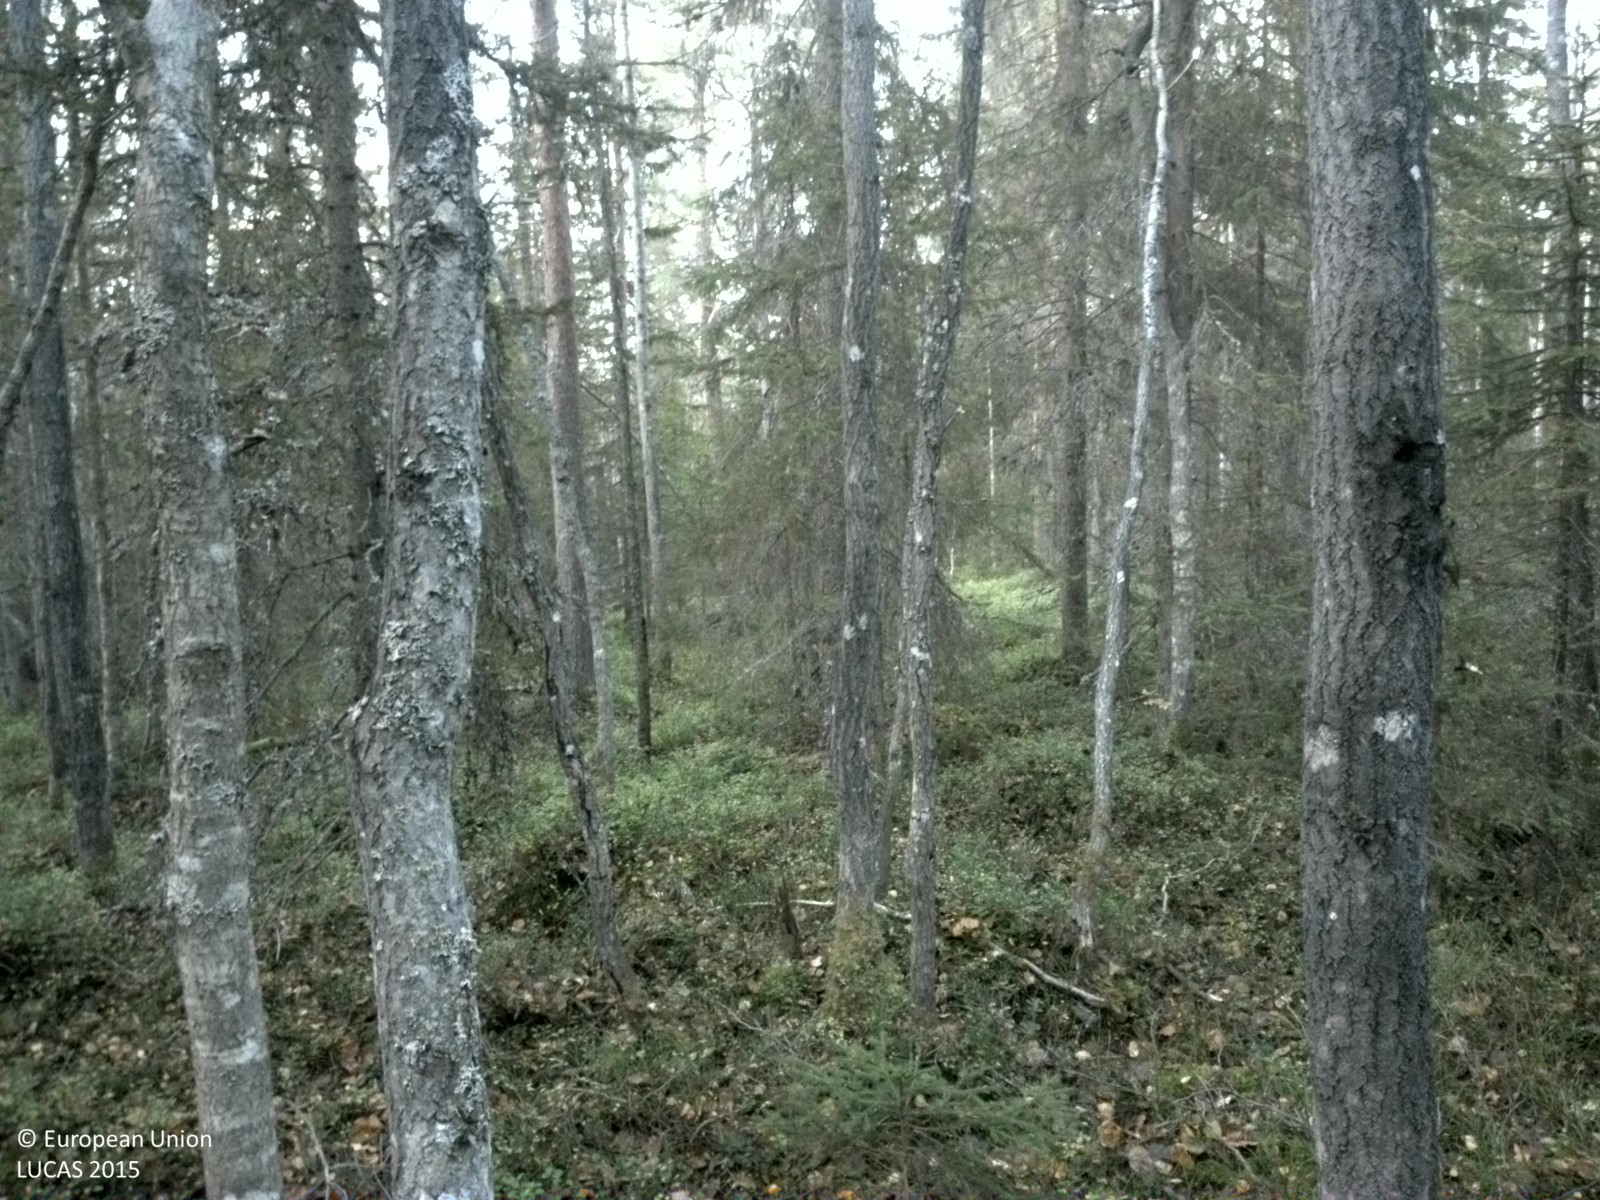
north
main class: Woodland
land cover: Spruce dominated mixed woodland
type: boreal forest
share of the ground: 50 - 75 %
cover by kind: shrubs 40 %, coniferous forest trees 35 %, broadleaved forest trees 25 %
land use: Amenities, museums, leisure
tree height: > 5 m
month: October
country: SE
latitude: 65.5923
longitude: 21.9710
